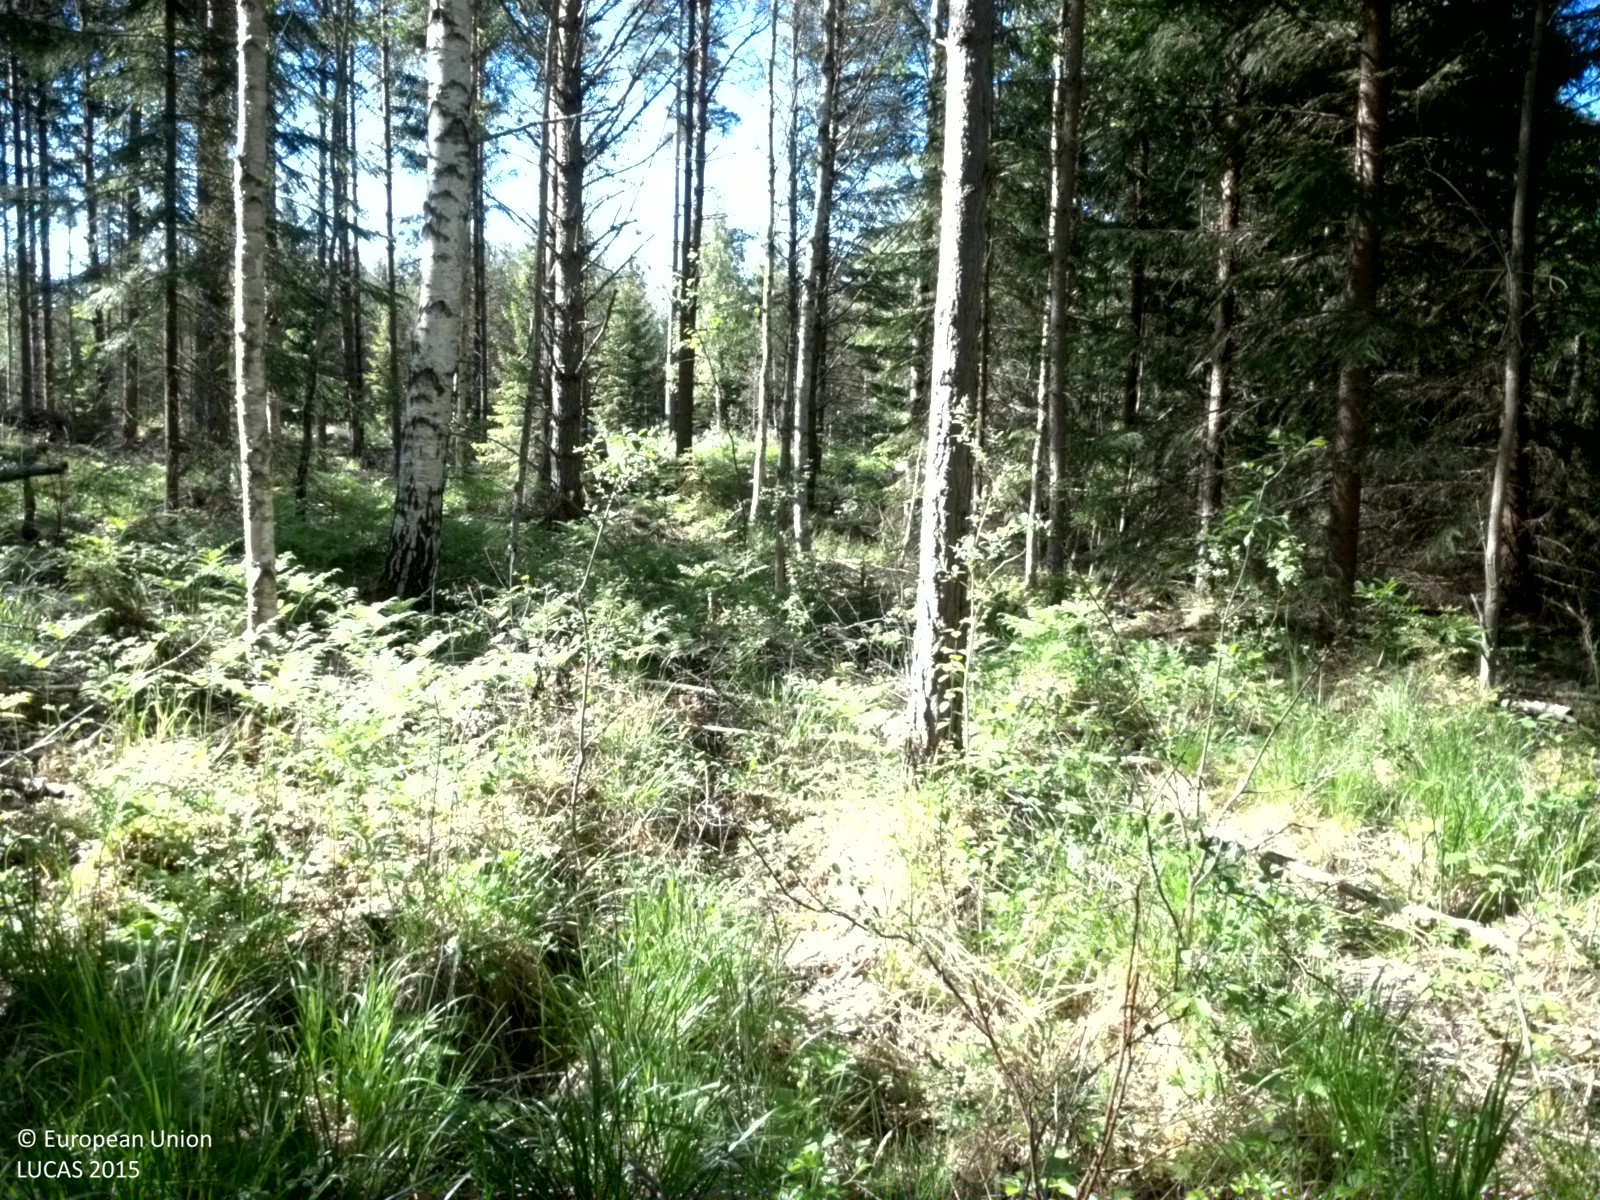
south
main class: Woodland
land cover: Pine dominated mixed woodland
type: boreal forest
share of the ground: 50 - 75 %
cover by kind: coniferous forest trees 45 %, broadleaved forest trees 20 %, herbaceous plants 20 %, shrubs 10 %
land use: Forestry
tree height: > 5 m
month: June
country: SE
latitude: 60.2312
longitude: 17.5579
